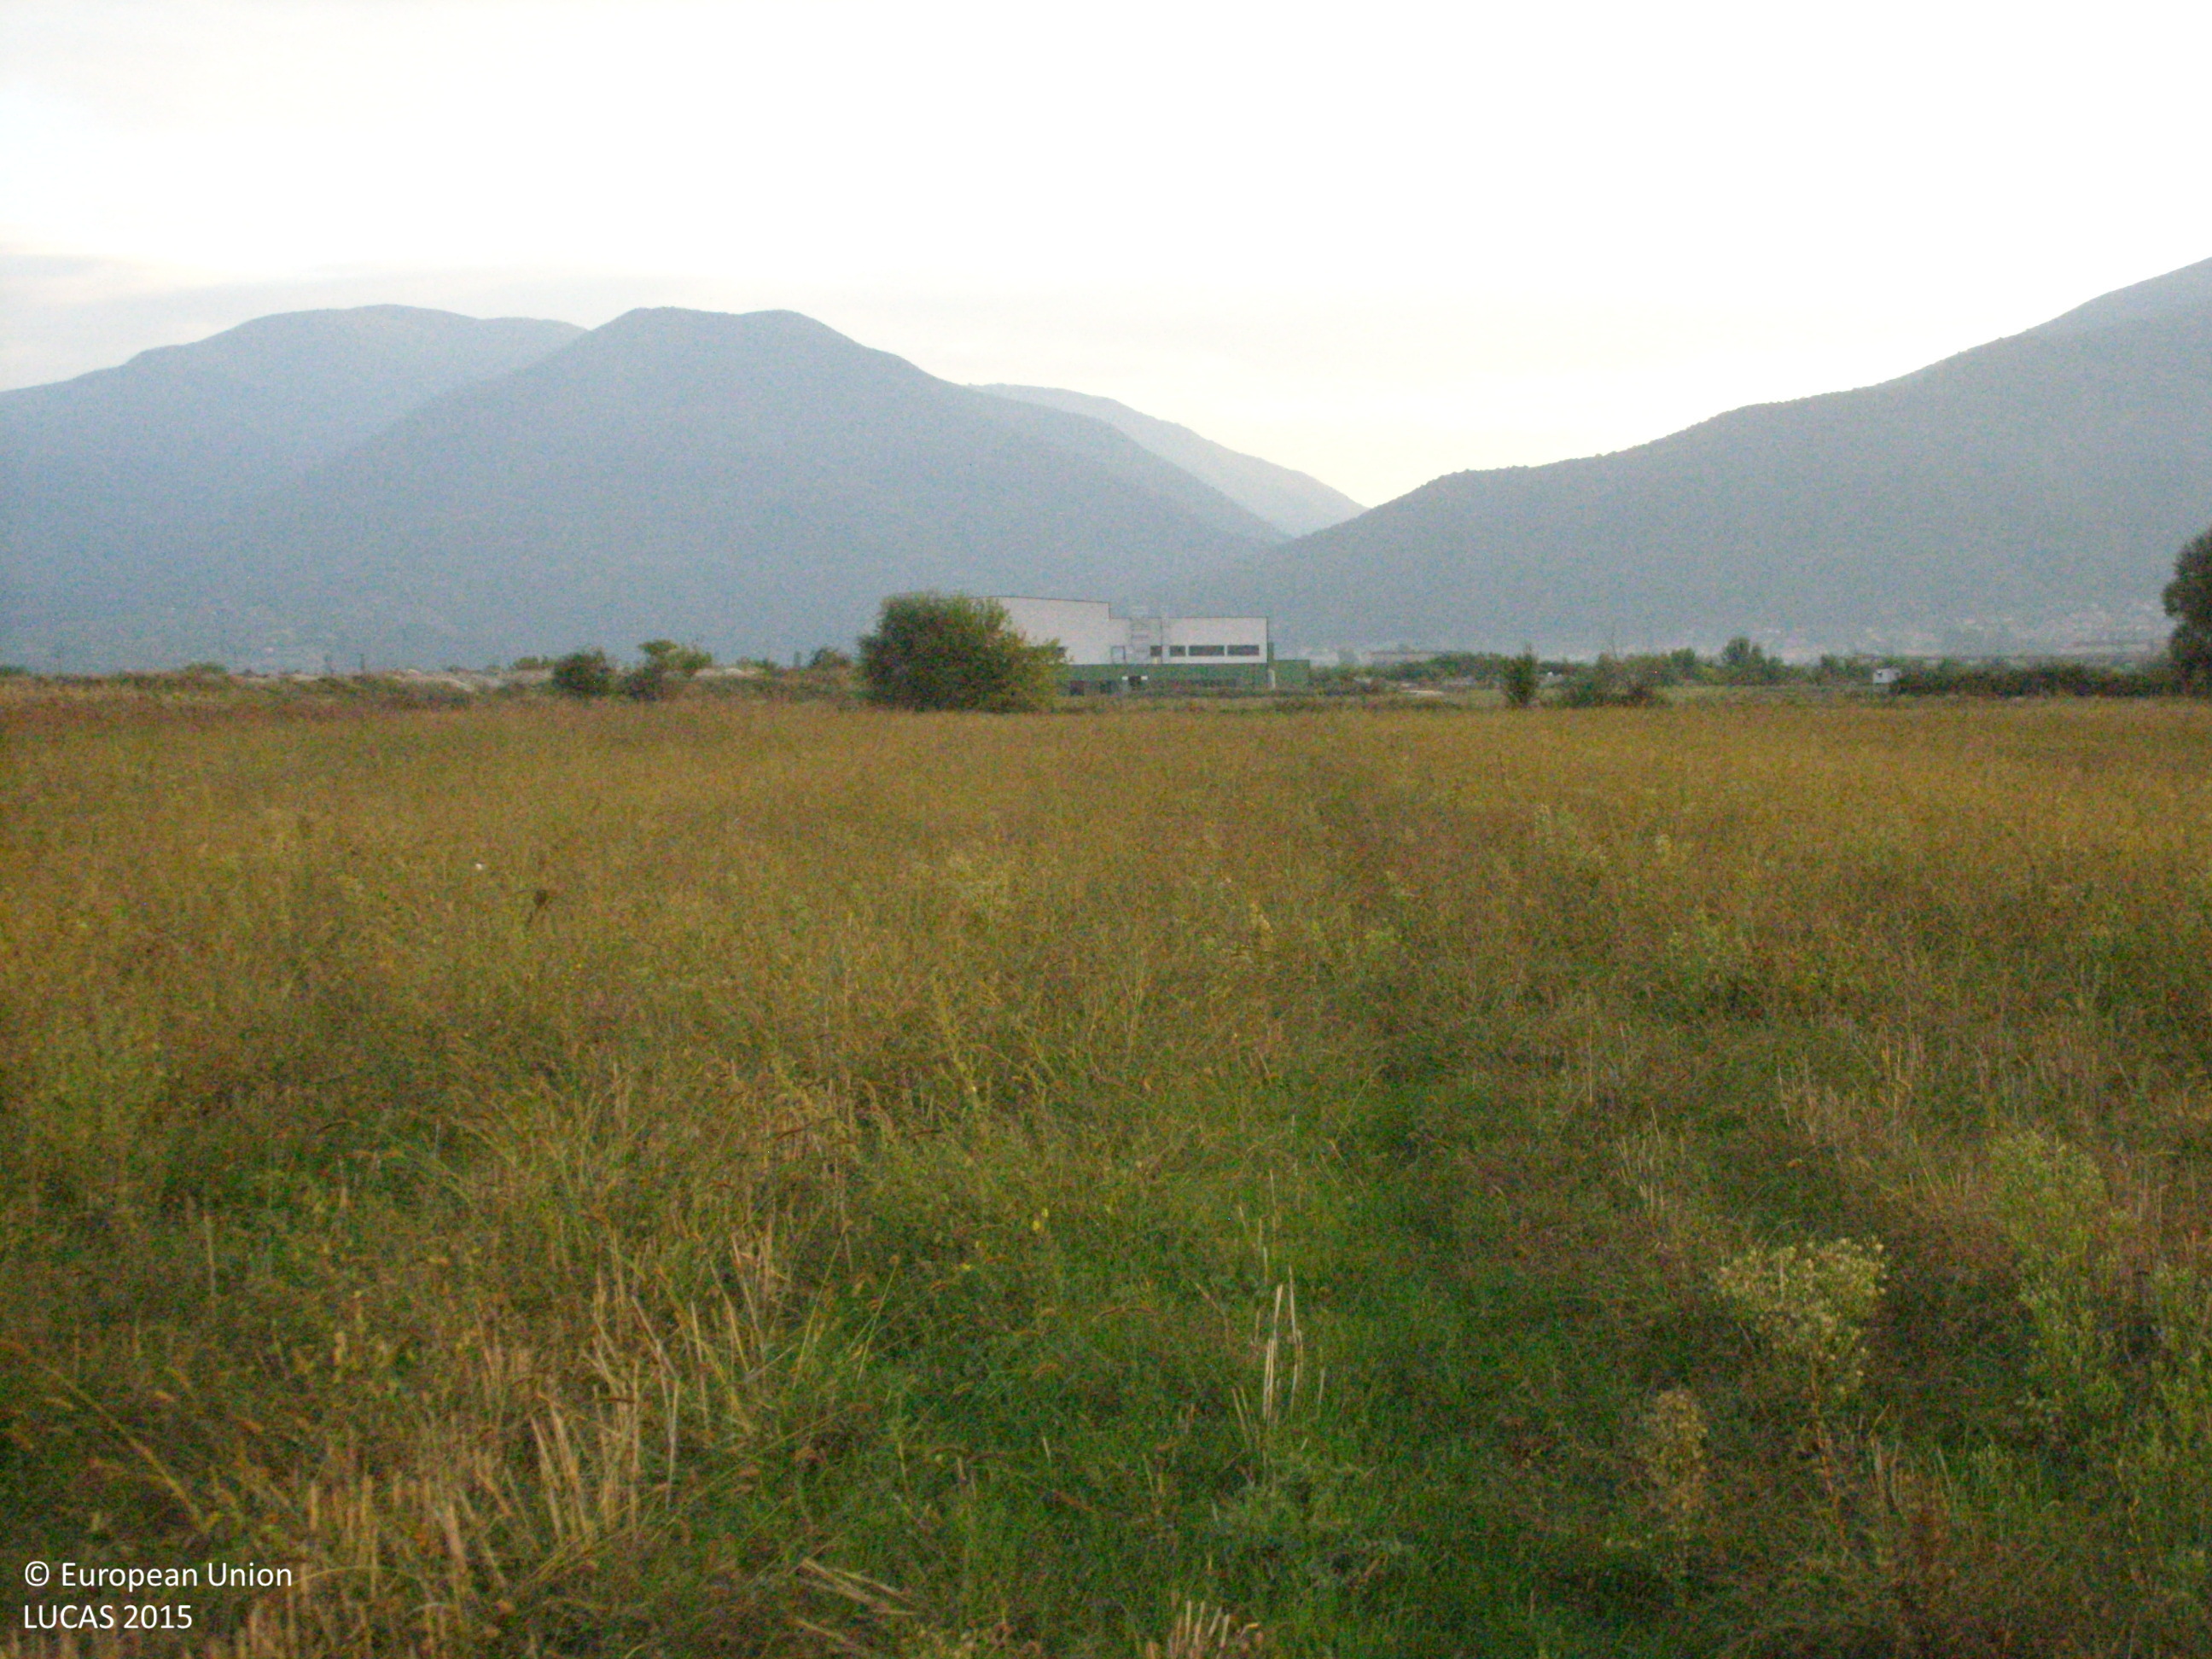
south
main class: Cropland
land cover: Common wheat
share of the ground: 10 - 25 %
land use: Agriculture (excluding fallow land and kitchen gardens)
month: October
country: BG
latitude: 42.1862
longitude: 24.1476
